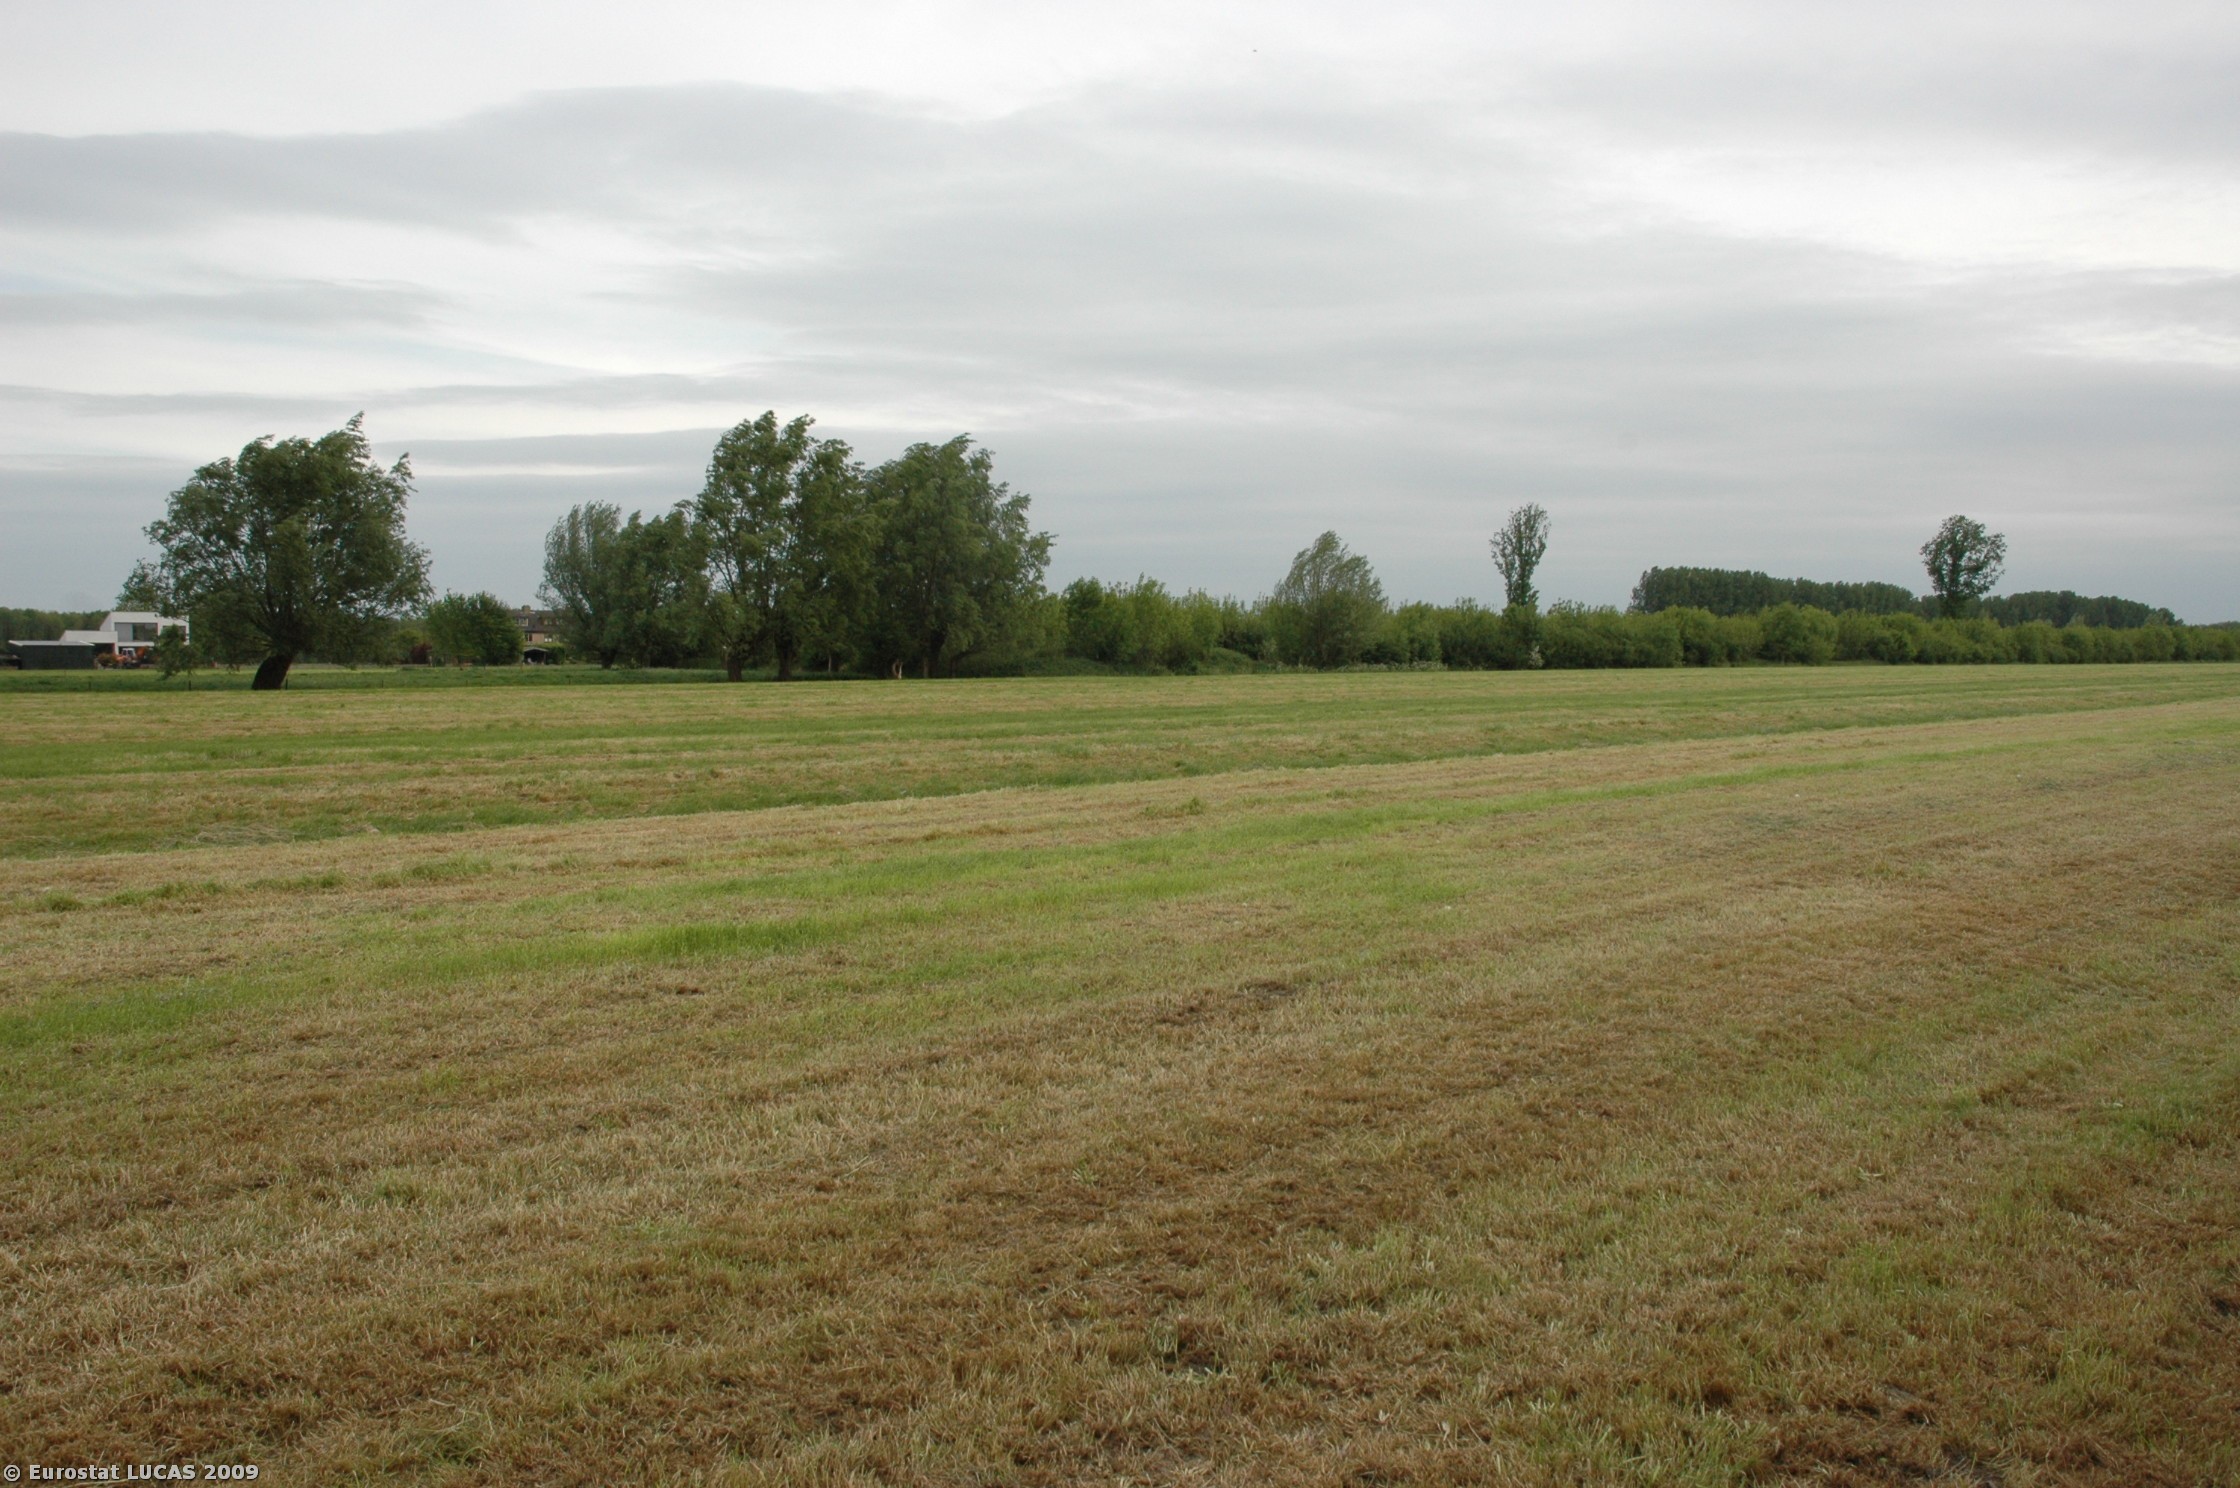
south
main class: Grassland
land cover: Grassland without tree/shrub cover
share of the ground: > 75 %
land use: Unused
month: May
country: NL
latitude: 51.9984
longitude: 5.3517
